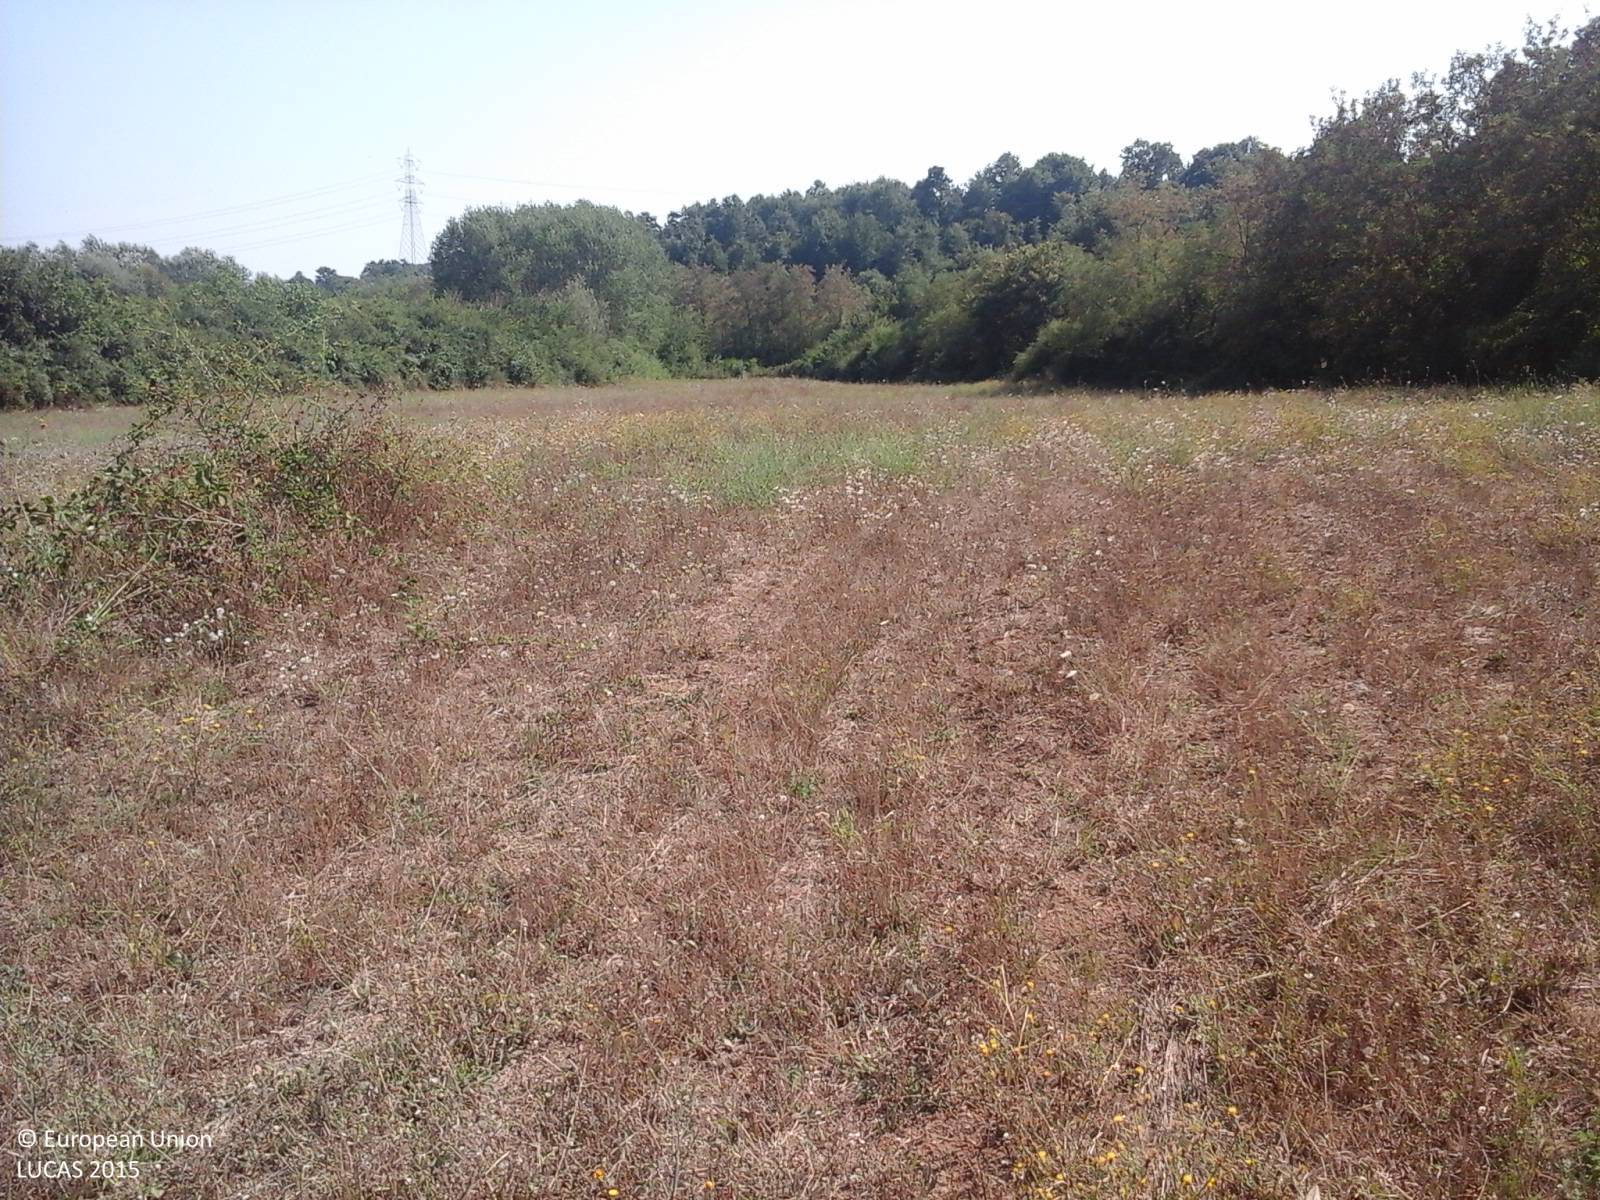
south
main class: Cropland
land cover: Mixed cereals for fodder
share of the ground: > 75 %
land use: Agriculture (excluding fallow land and kitchen gardens)
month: August
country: IT
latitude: 42.2350
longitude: 12.0889
